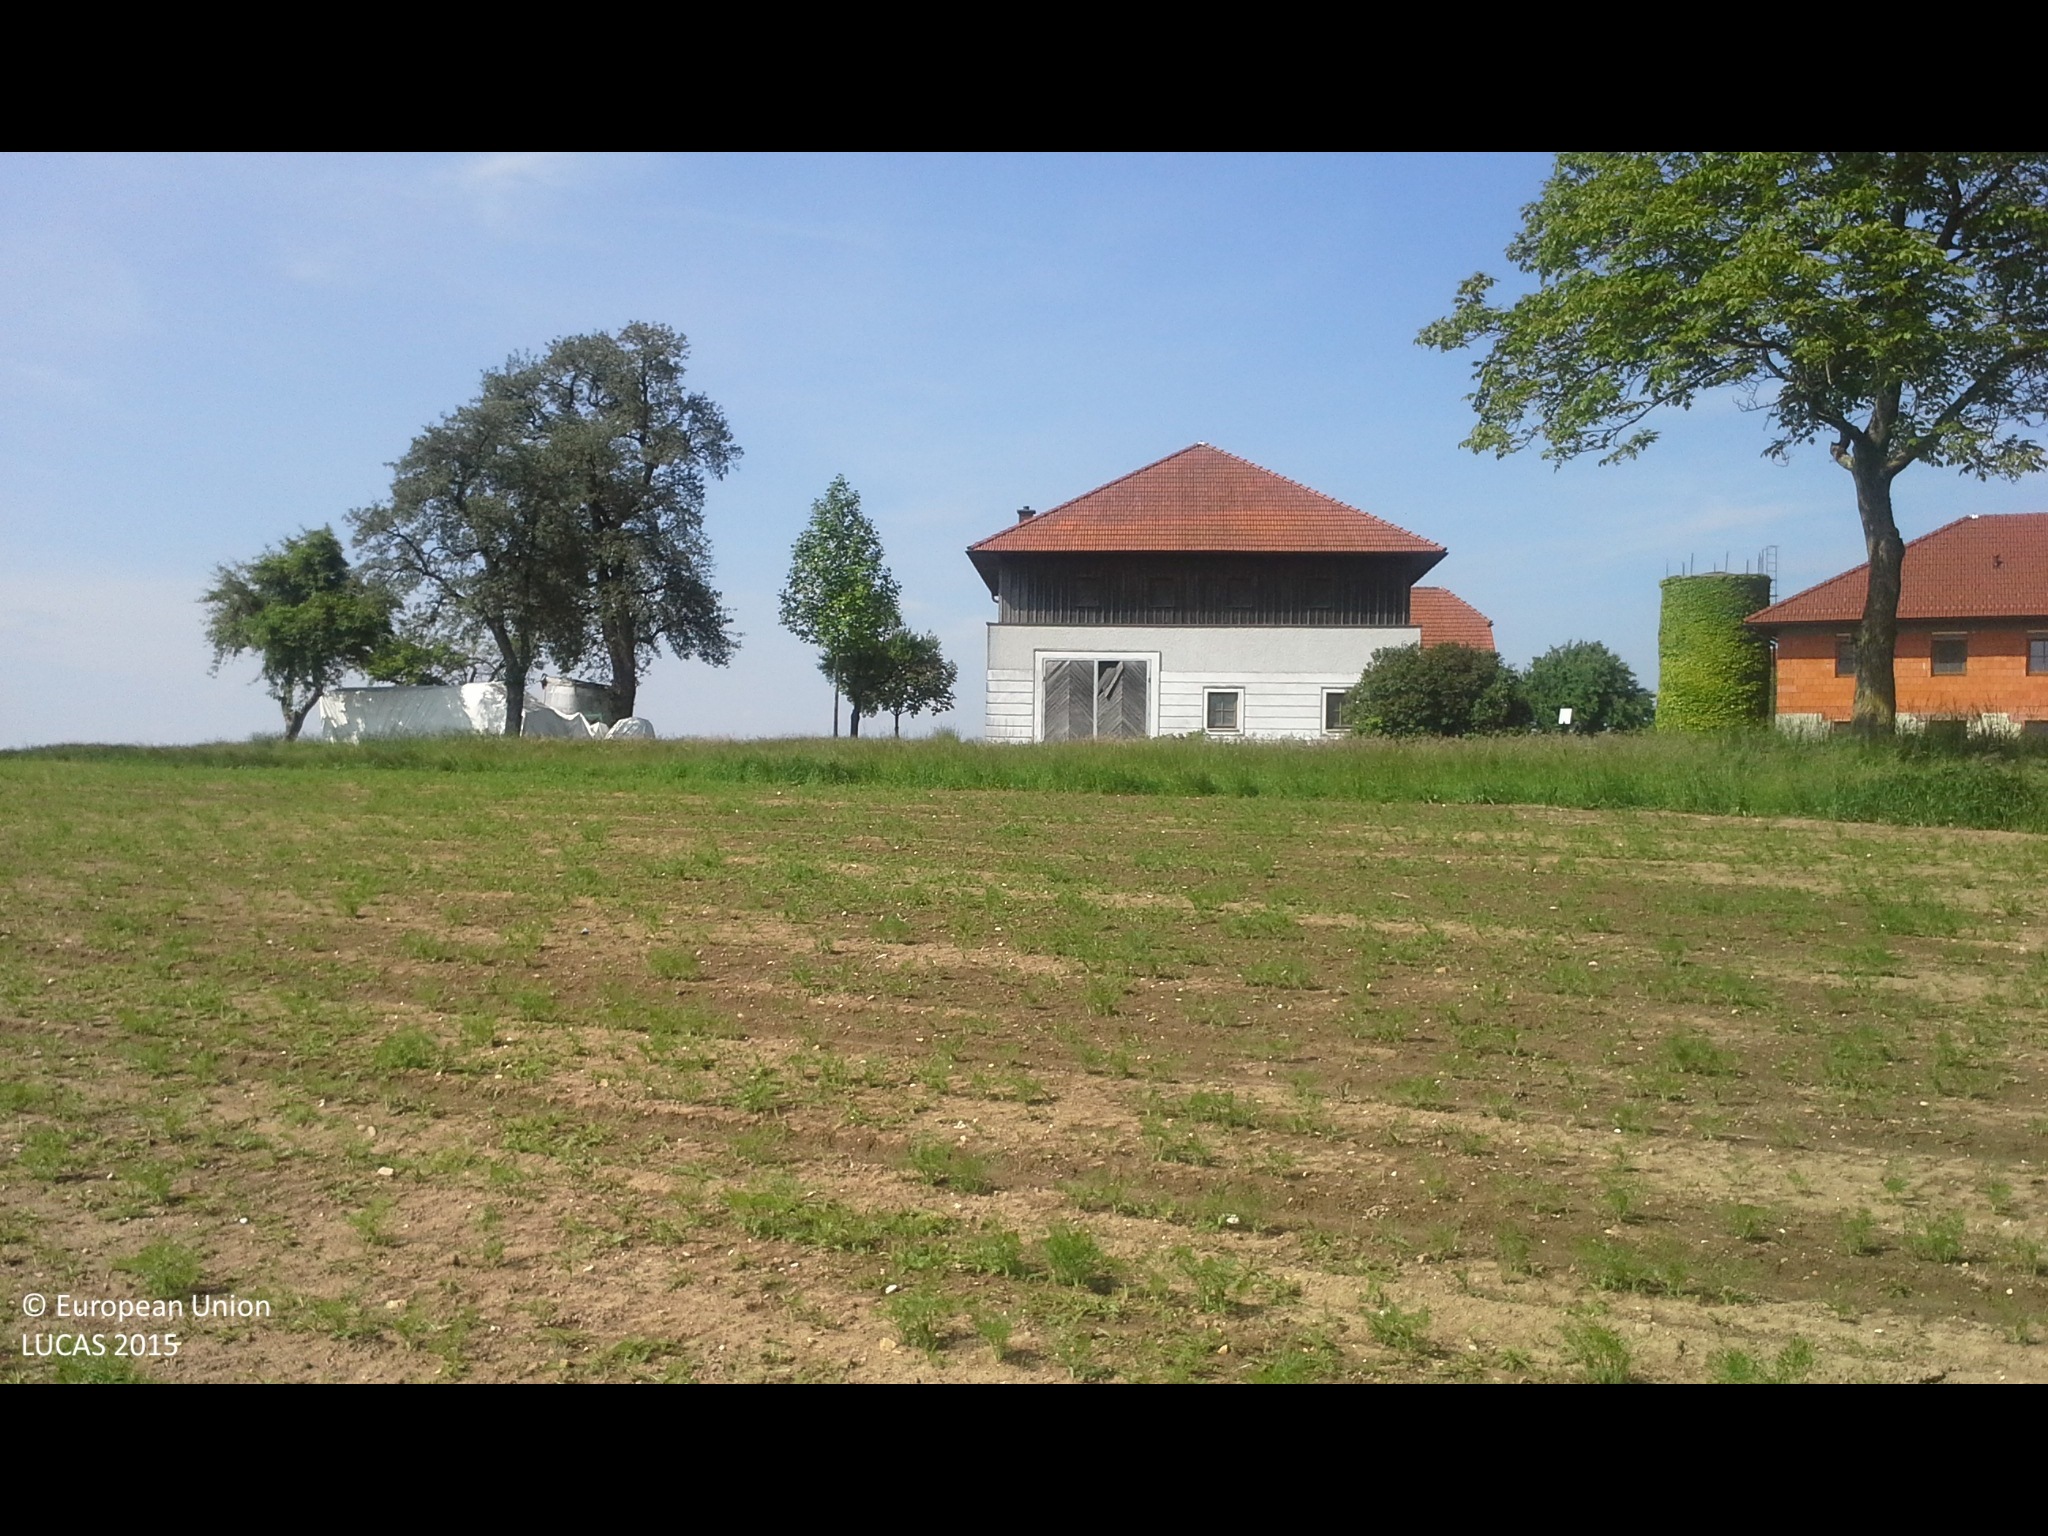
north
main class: Cropland
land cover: Other fresh vegetables
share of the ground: 10 - 25 %
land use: Agriculture (excluding fallow land and kitchen gardens)
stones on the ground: 25 - 50 %
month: May
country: AT
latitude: 48.0155
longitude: 14.2496
